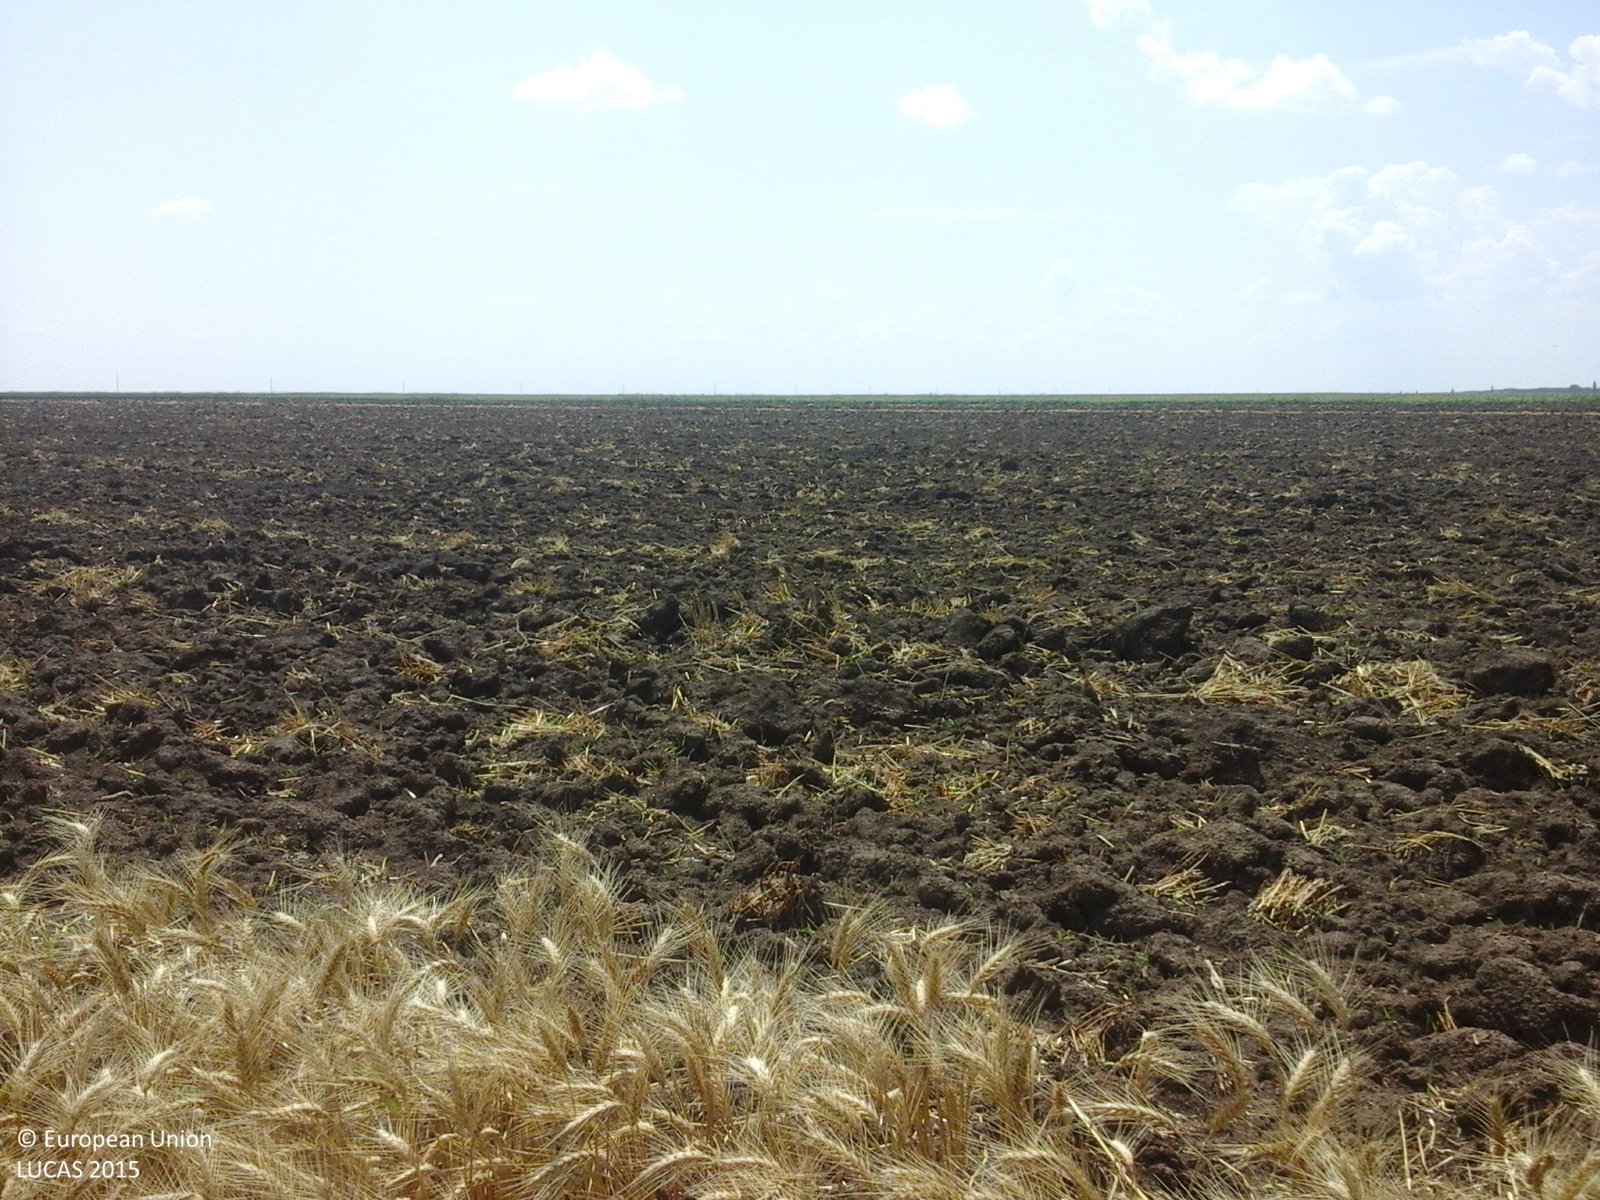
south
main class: Cropland
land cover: Common wheat
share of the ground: > 75 %
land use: Agriculture (excluding fallow land and kitchen gardens)
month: July
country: RO
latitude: 44.0710
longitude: 25.8909
